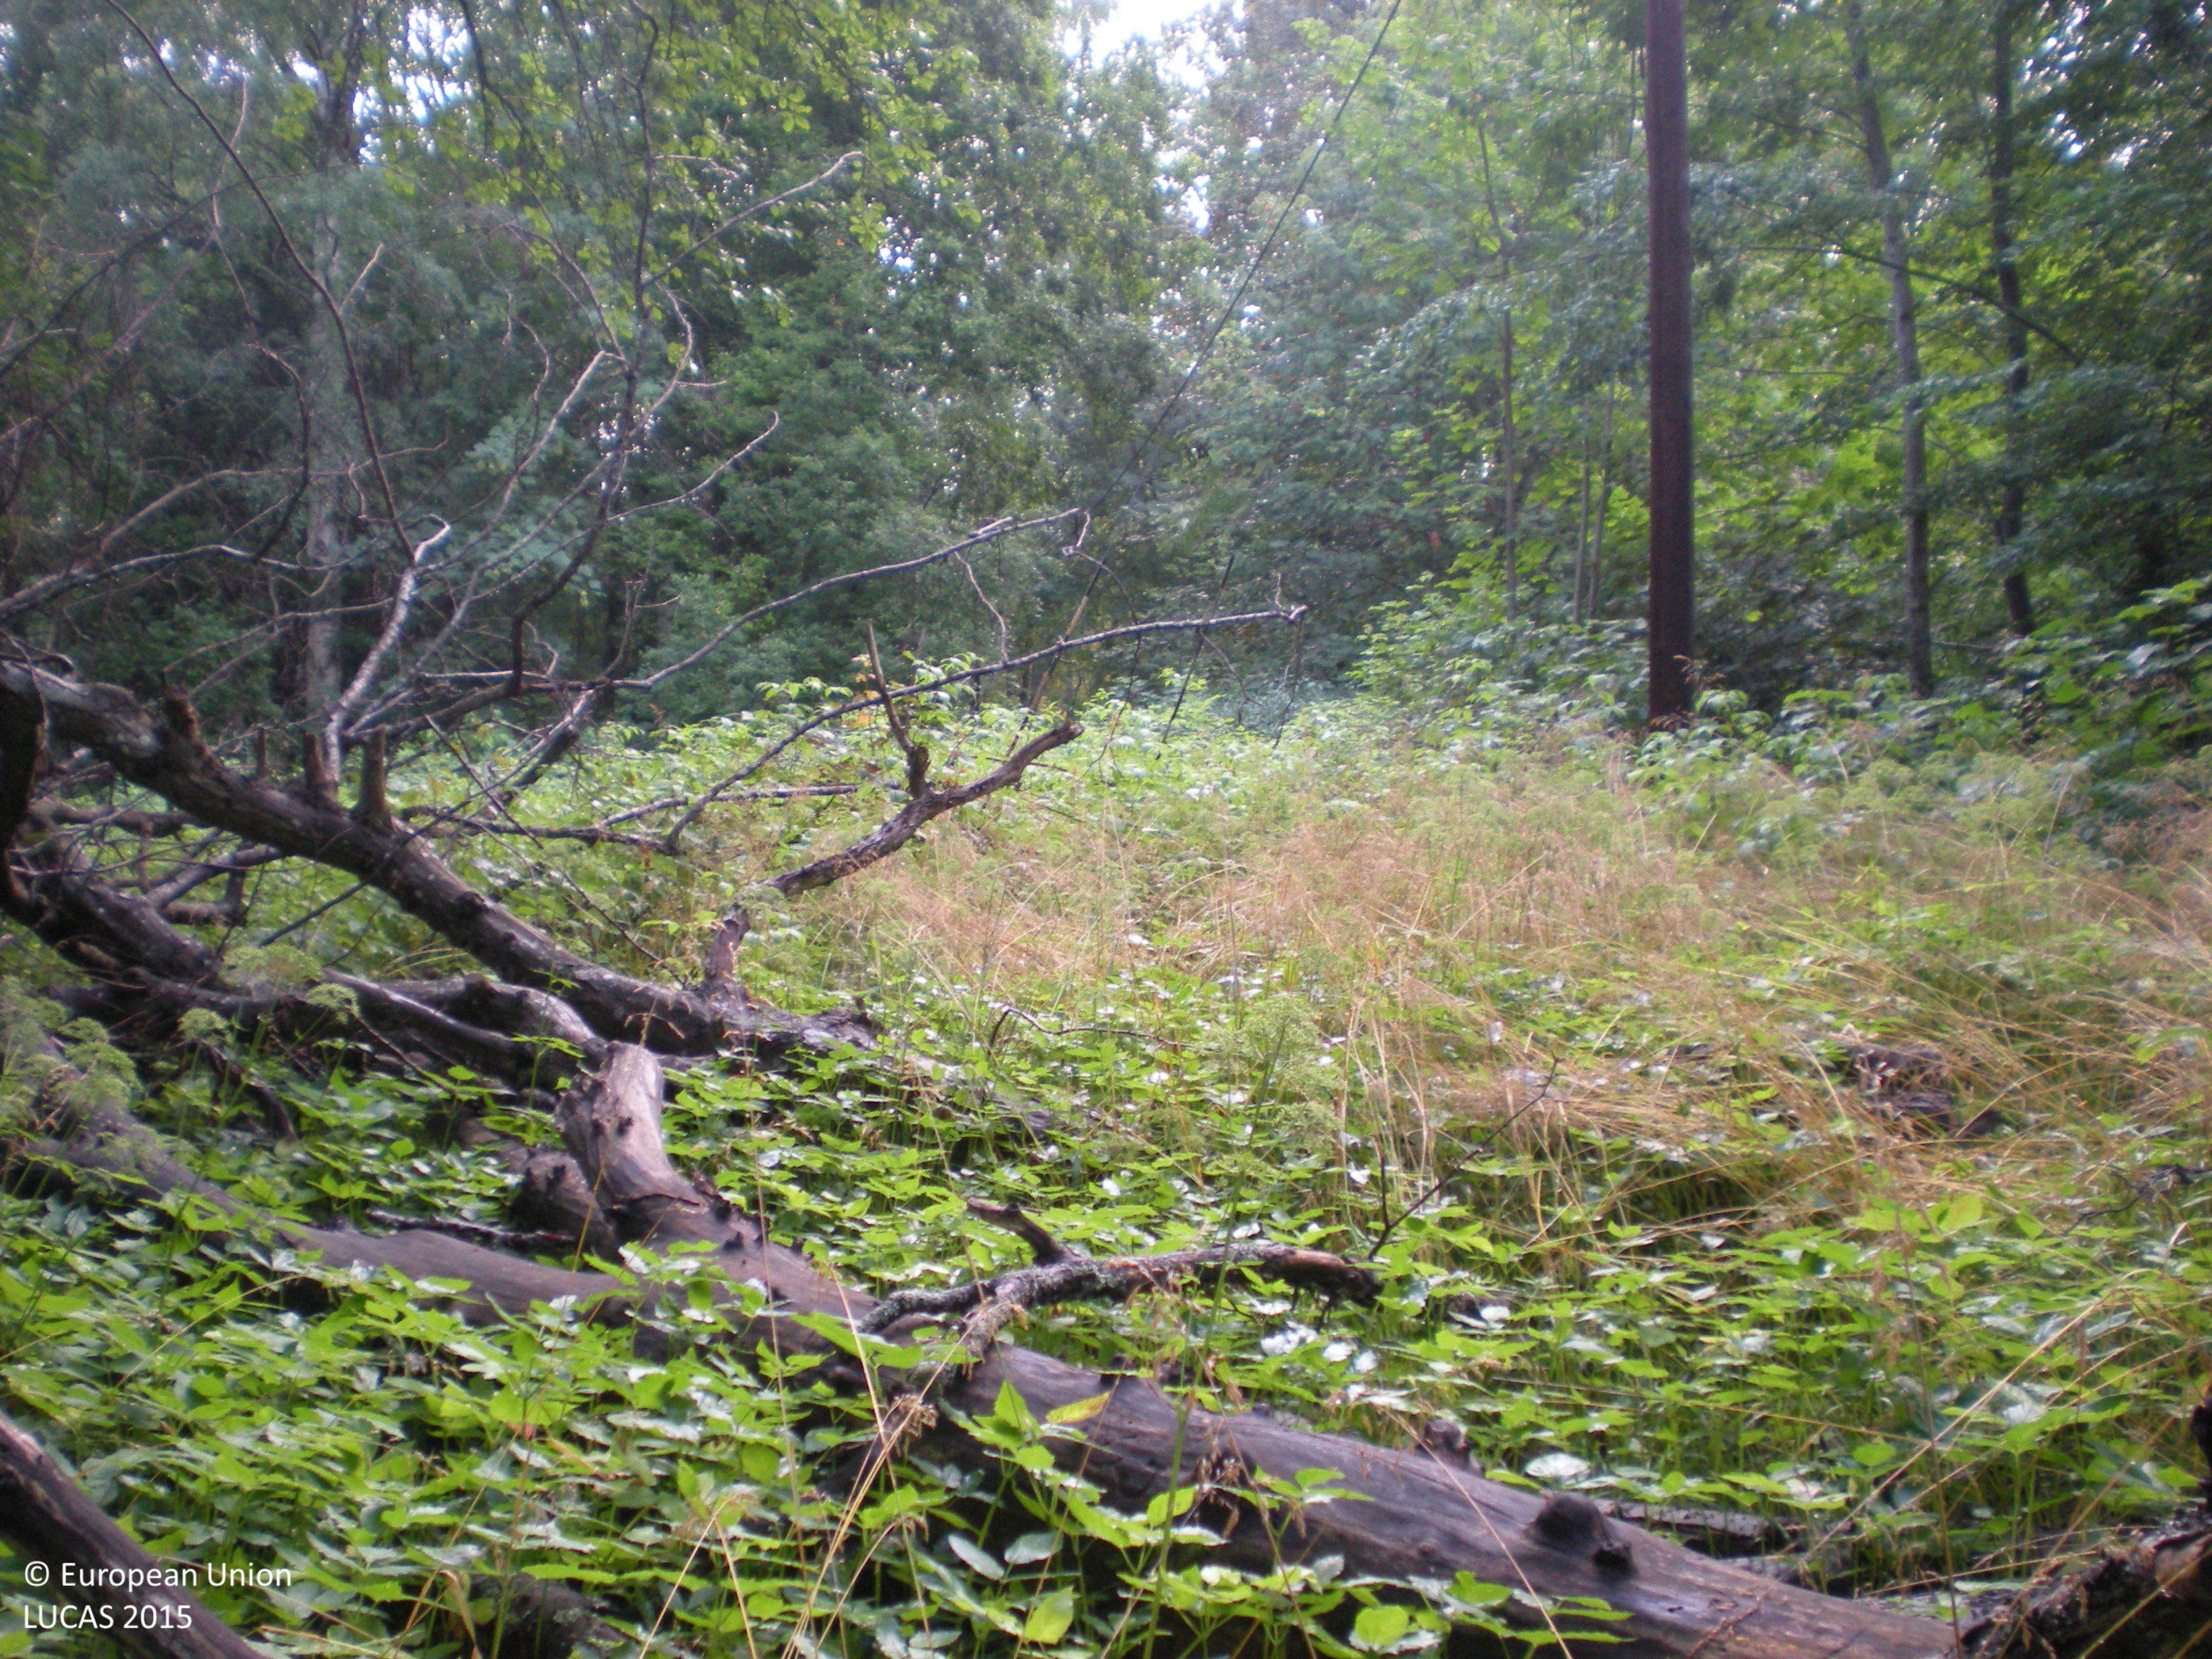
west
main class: Woodland
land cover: Broadleaved woodland
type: boreal forest
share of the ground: > 75 %
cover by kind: broadleaved forest trees 50 %, herbaceous plants 30 %, coniferous forest trees 10 %, lichens and mosses 5 %, unconsolidated bare surface 5 %
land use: Forestry
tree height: > 5 m
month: August
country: SE
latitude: 60.7009
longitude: 17.2251
